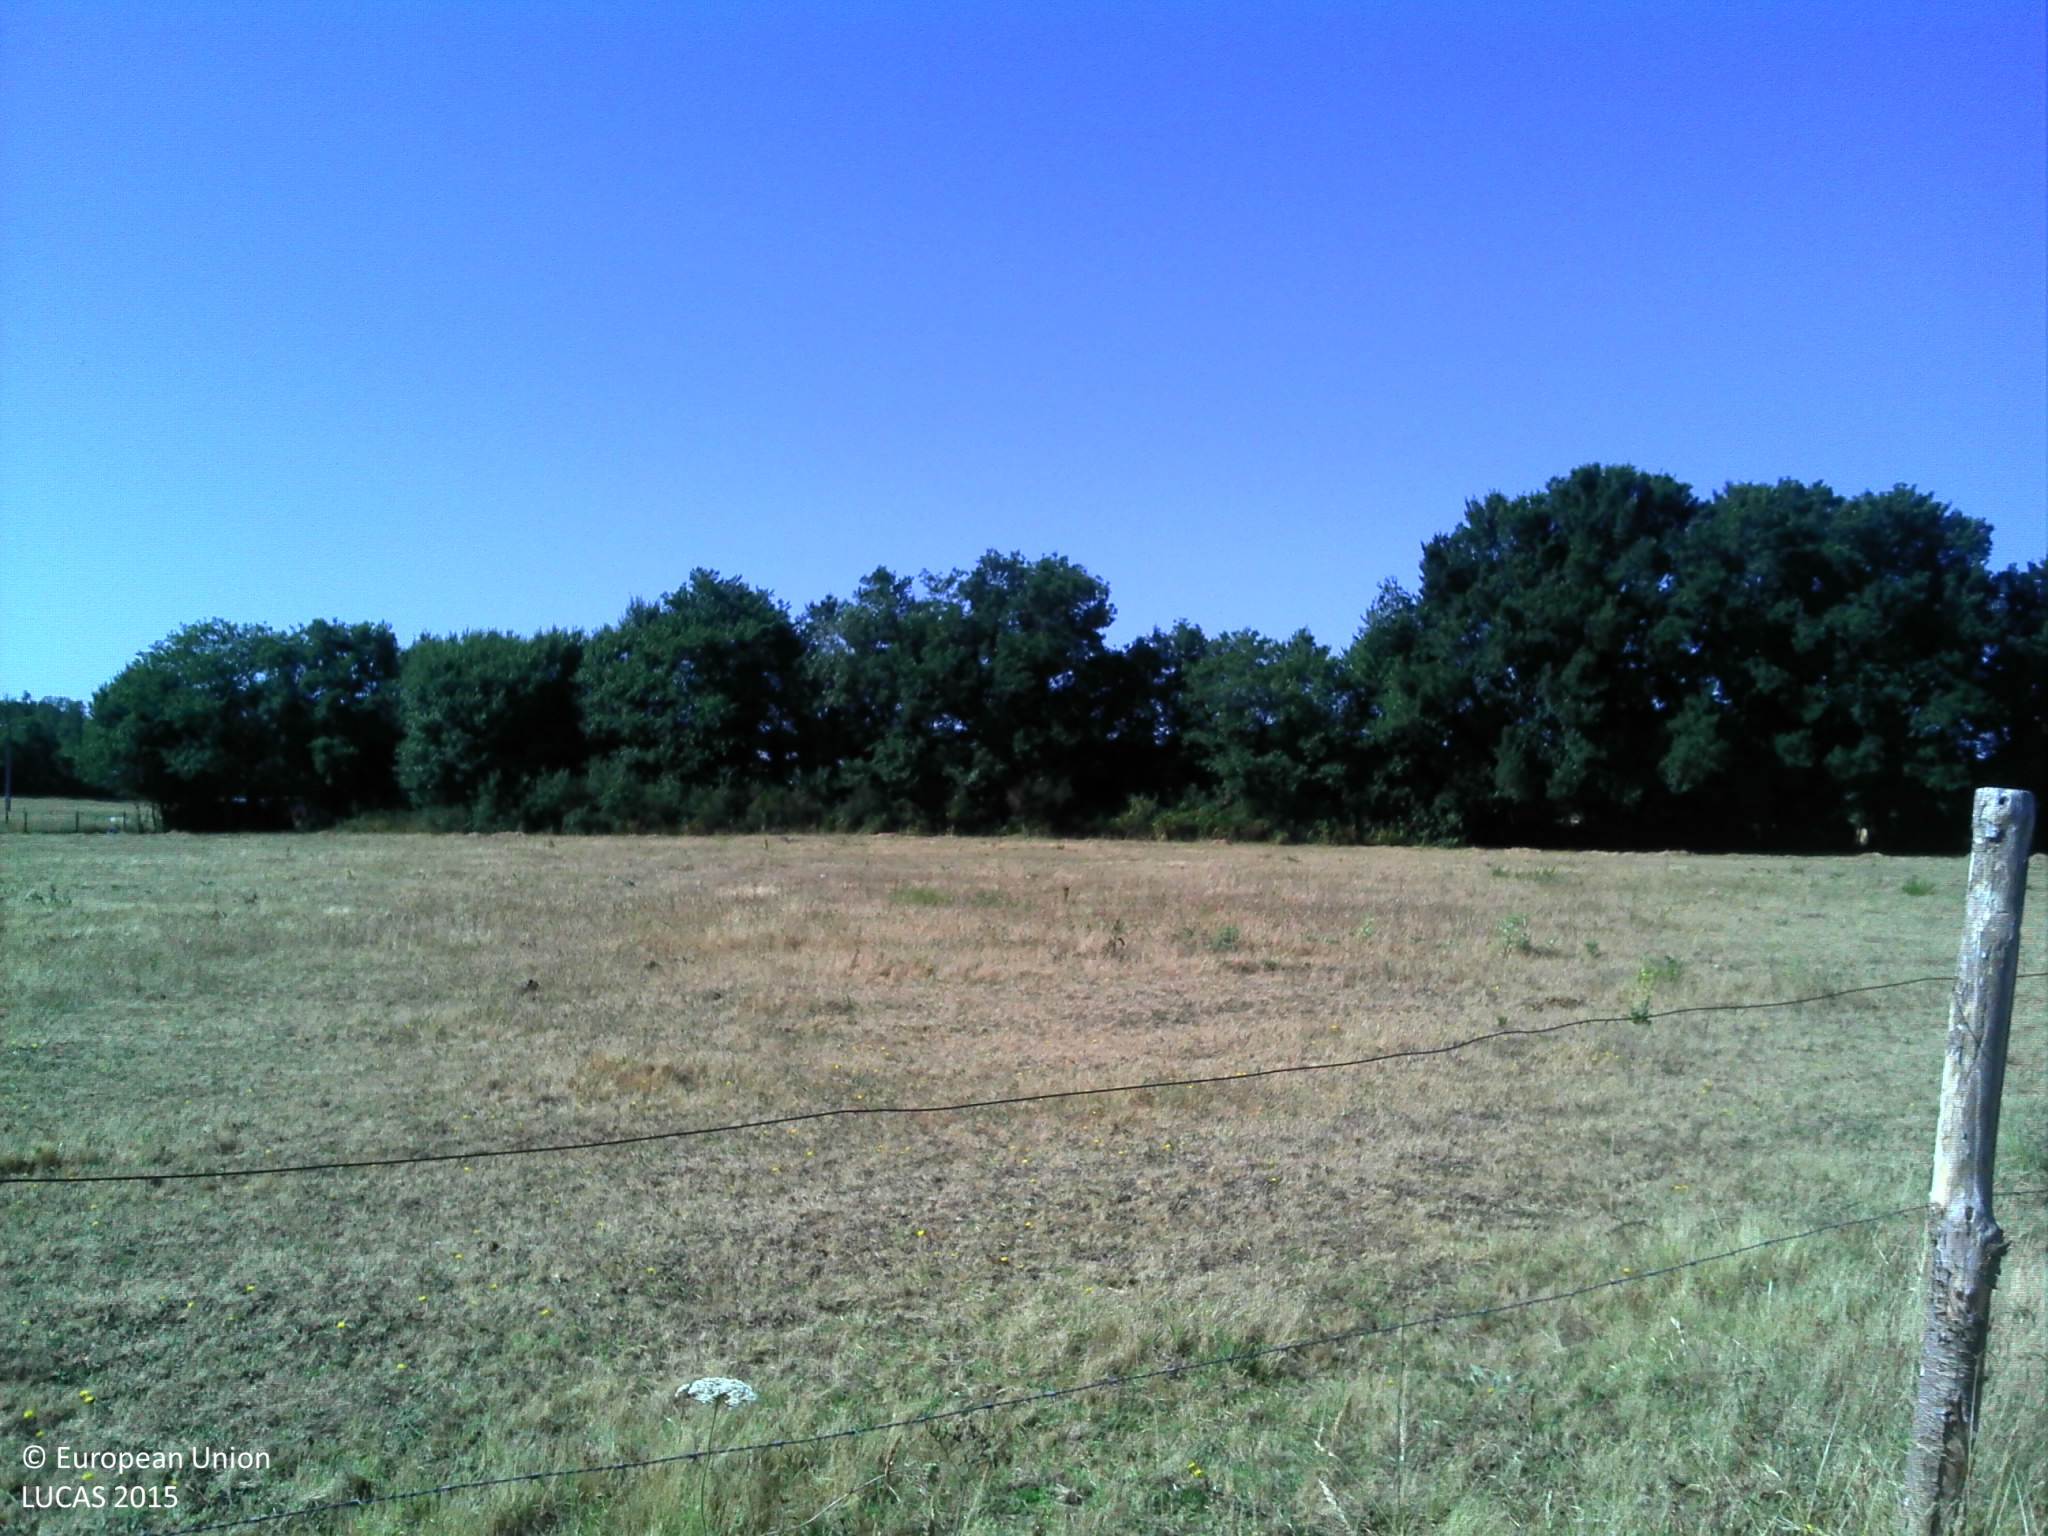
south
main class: Grassland
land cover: Grassland without tree/shrub cover
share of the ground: > 75 %
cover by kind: herbaceous plants 100 %
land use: Agriculture (excluding fallow land and kitchen gardens)
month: July
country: FR
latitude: 47.6473
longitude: 0.2712
